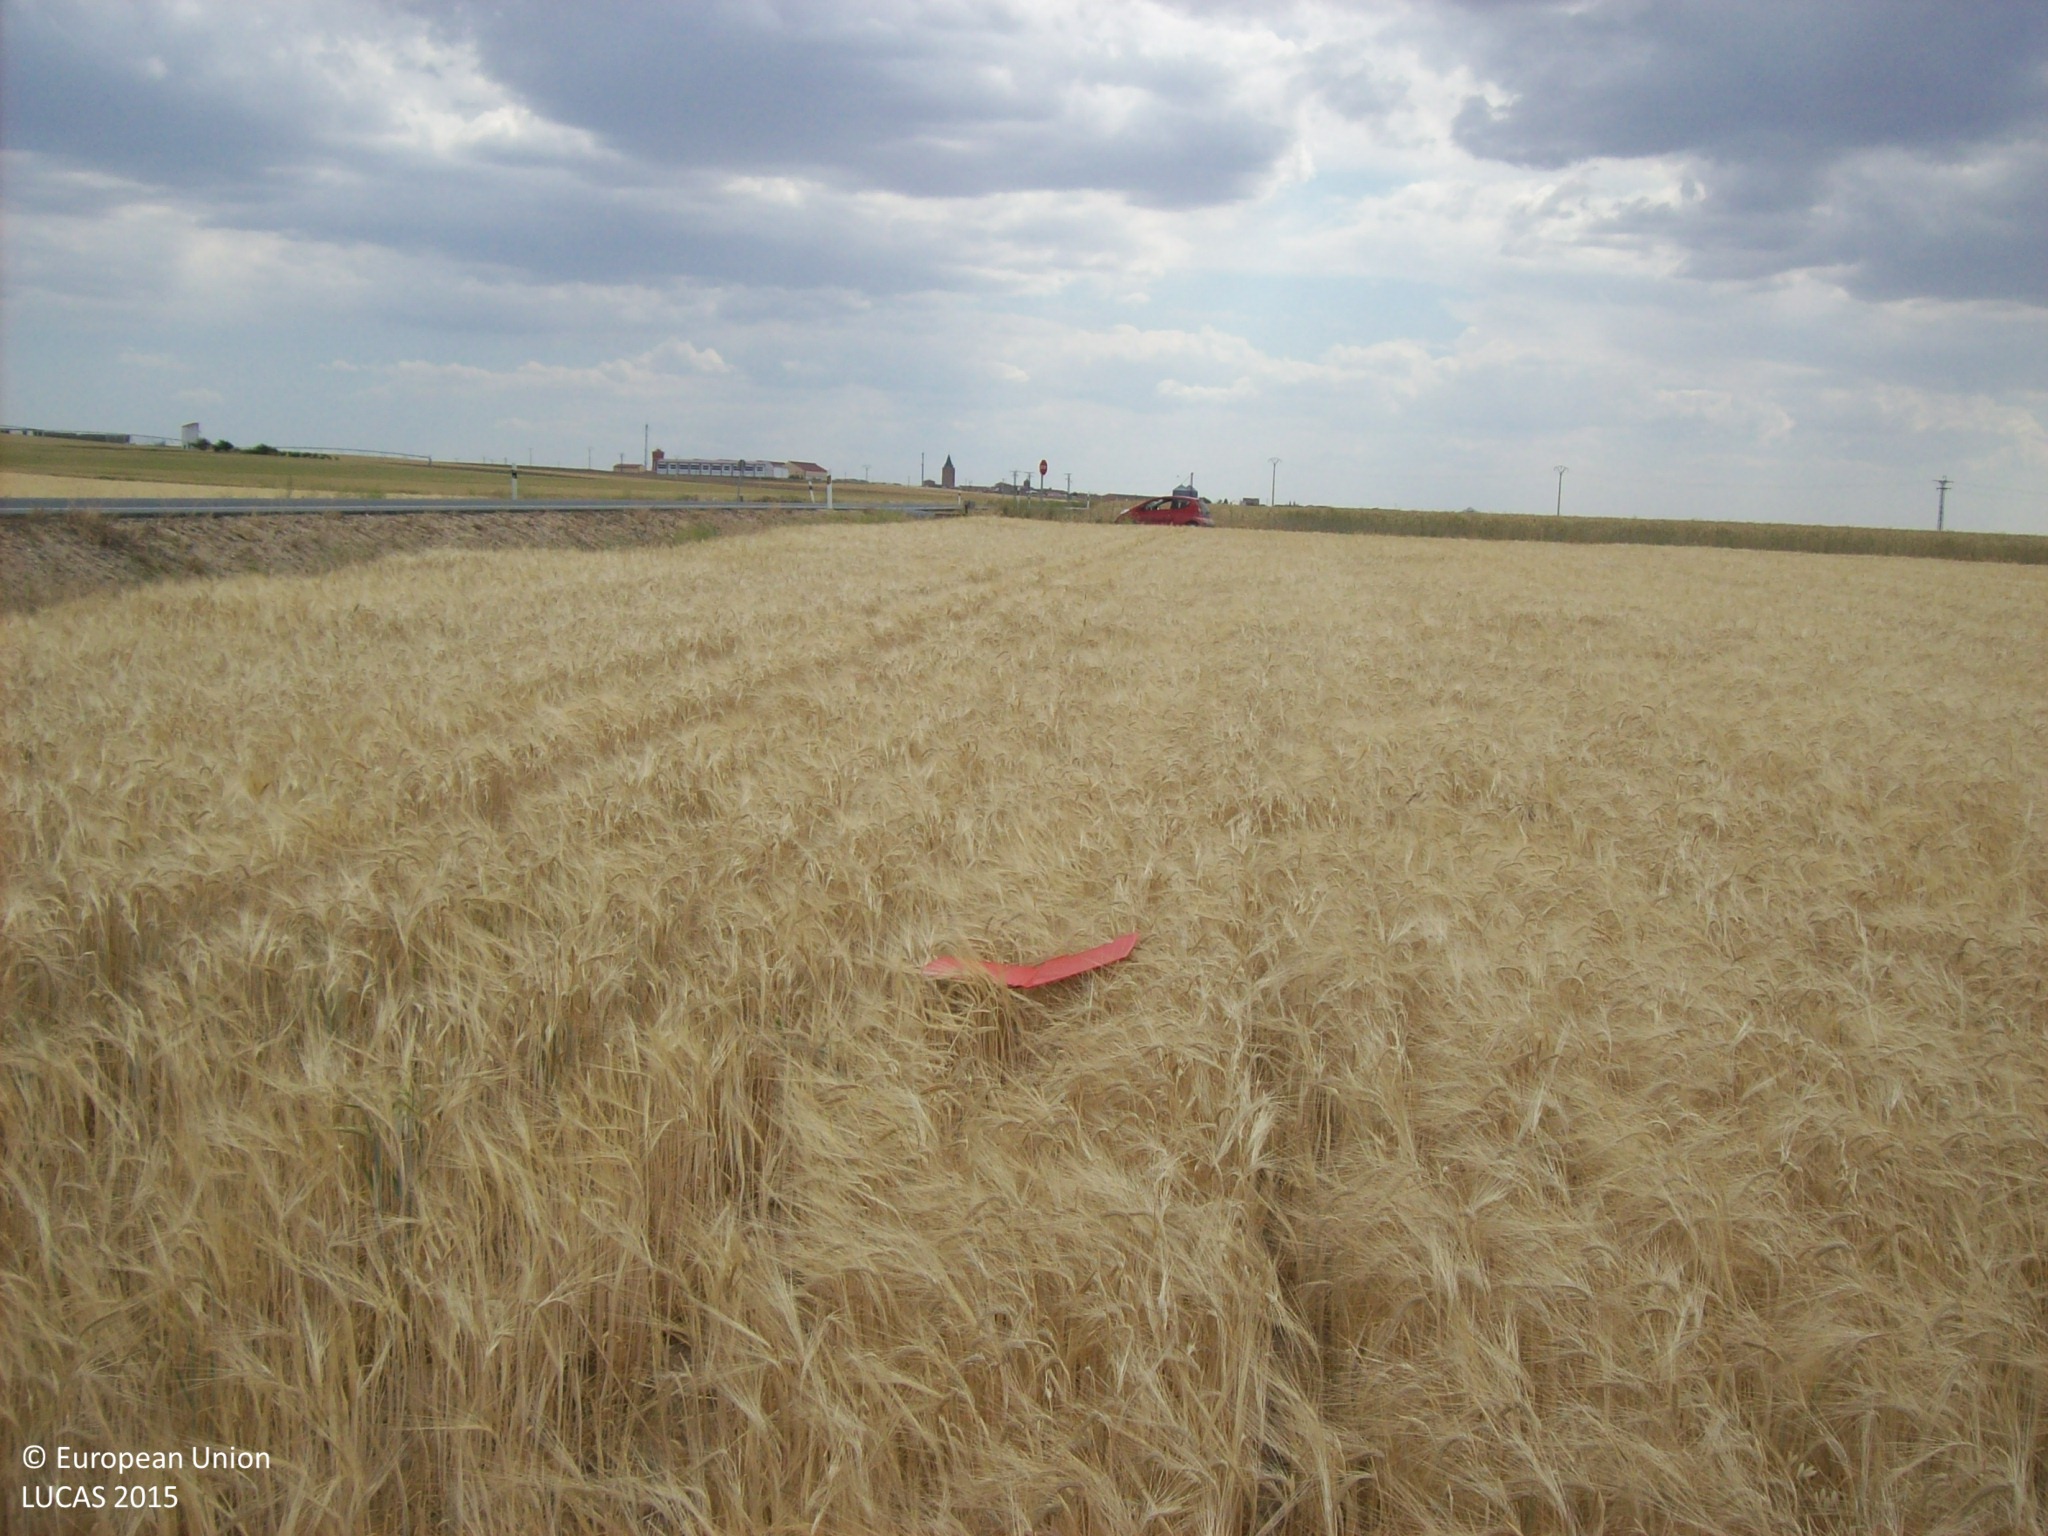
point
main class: Cropland
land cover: Barley
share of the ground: > 75 %
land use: Agriculture (excluding fallow land and kitchen gardens)
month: June
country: ES
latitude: 41.1097
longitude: -4.9877
